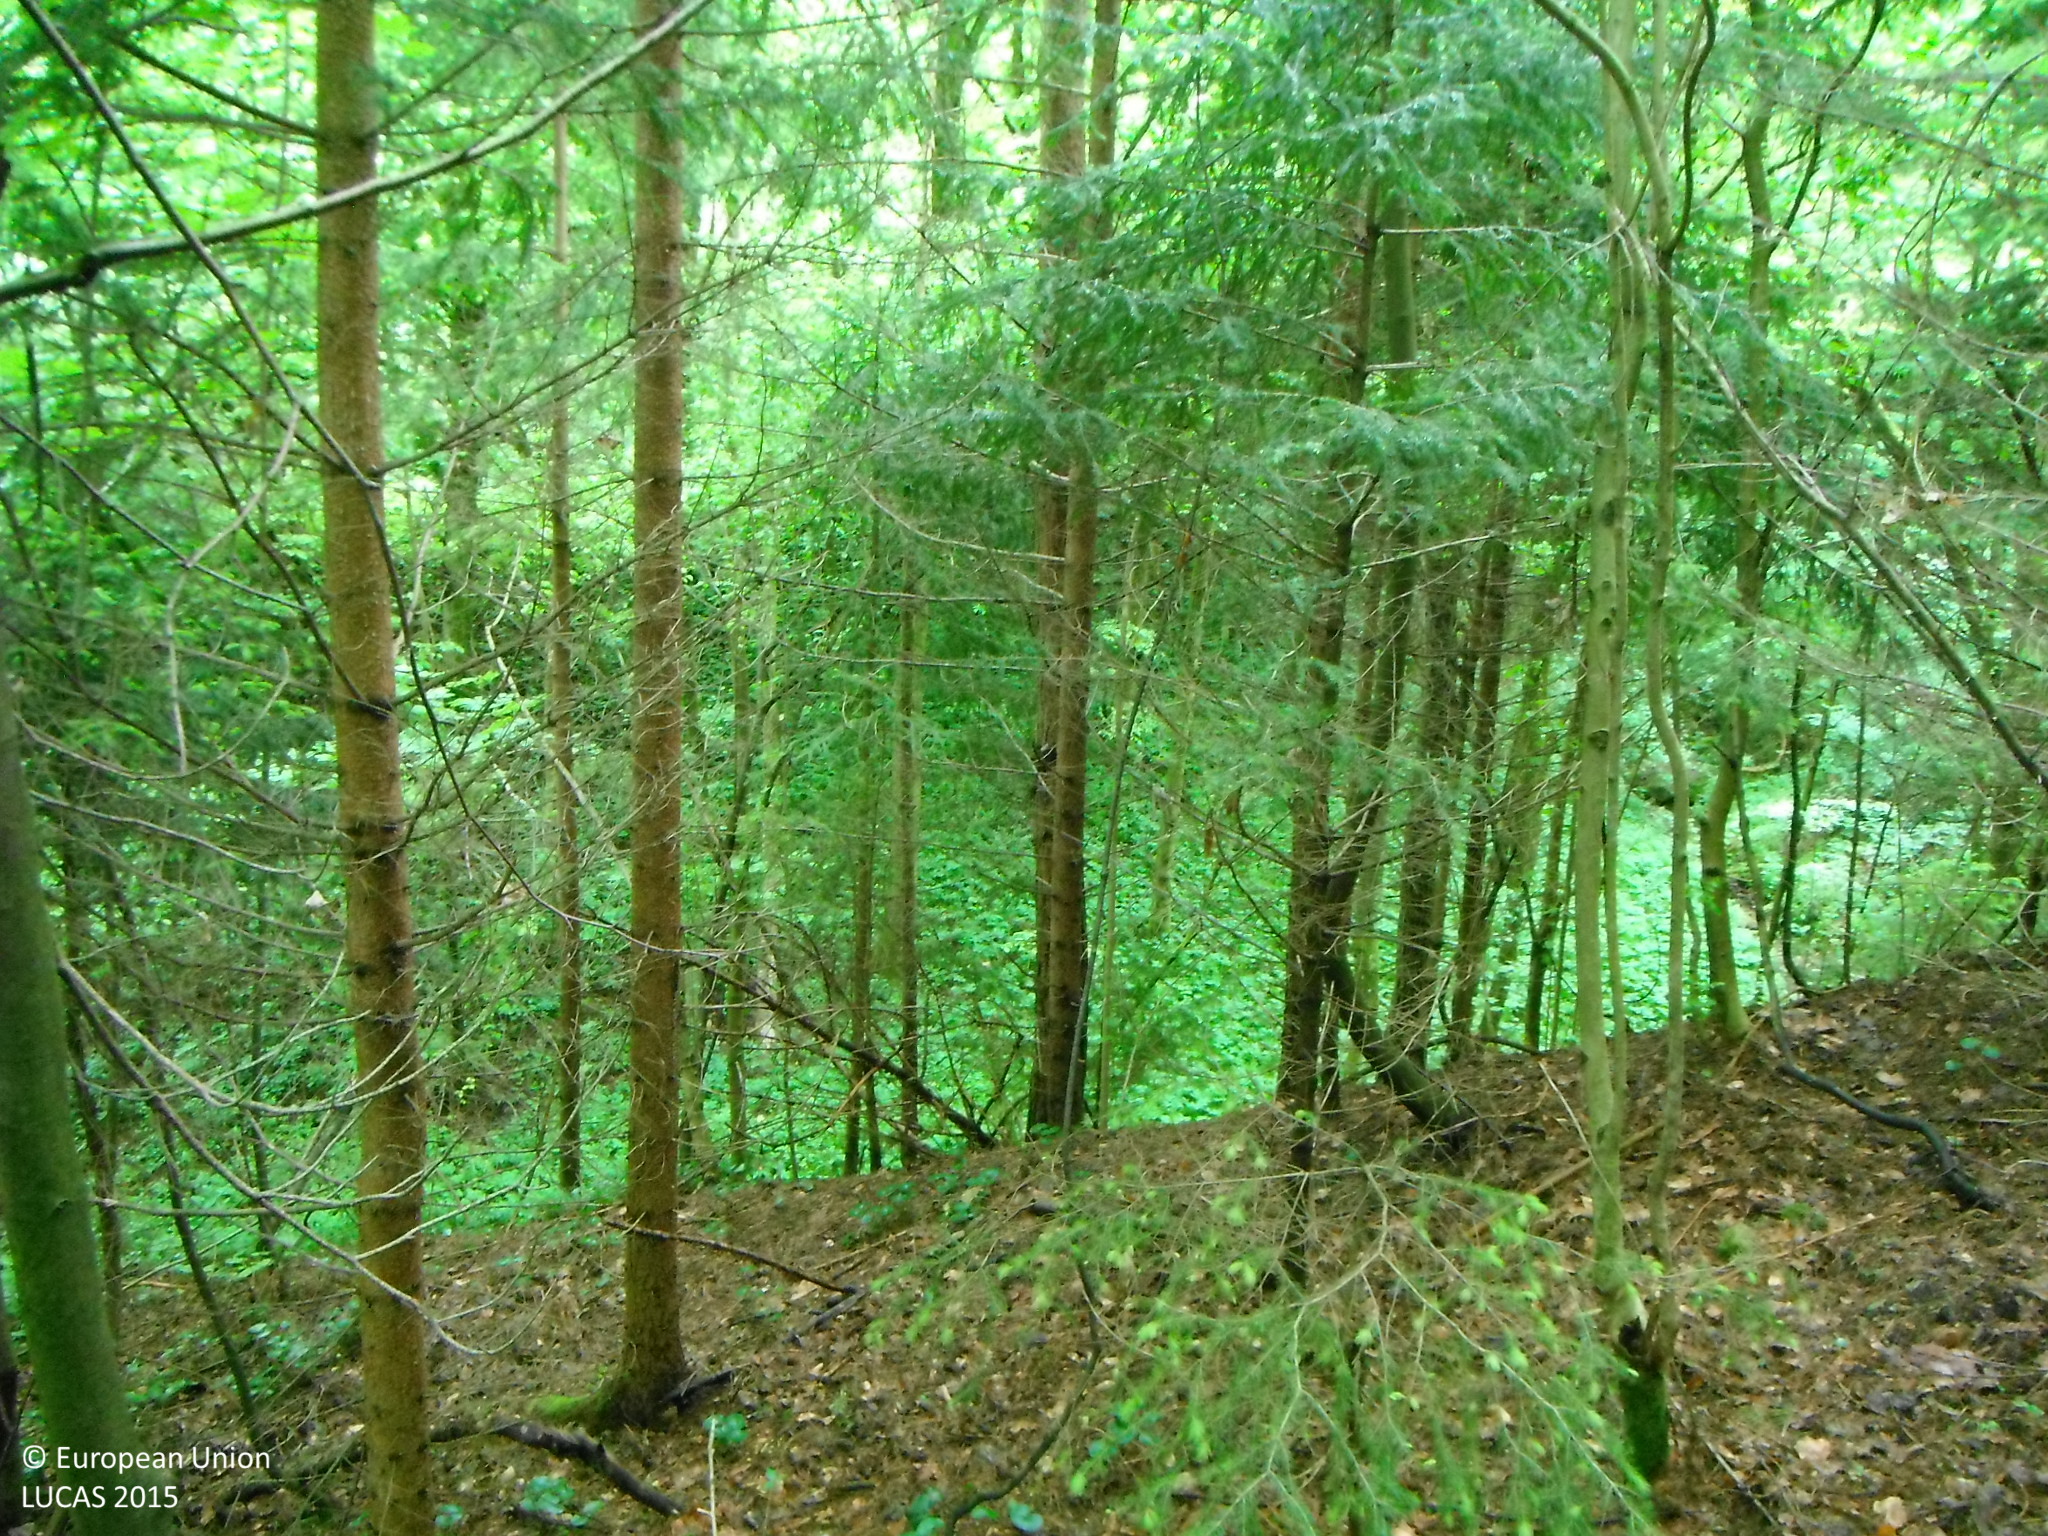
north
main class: Woodland
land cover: Spruce dominated mixed woodland
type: hemiboreal forest and nemoral coniferous forest and mixed broadleaved-coniferous forest
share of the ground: > 75 %
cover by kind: coniferous forest trees 70 %, broadleaved forest trees 30 %
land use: Semi-natural and natural areas not in use
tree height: > 5 m
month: May
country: SK
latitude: 48.7657
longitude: 19.1514
